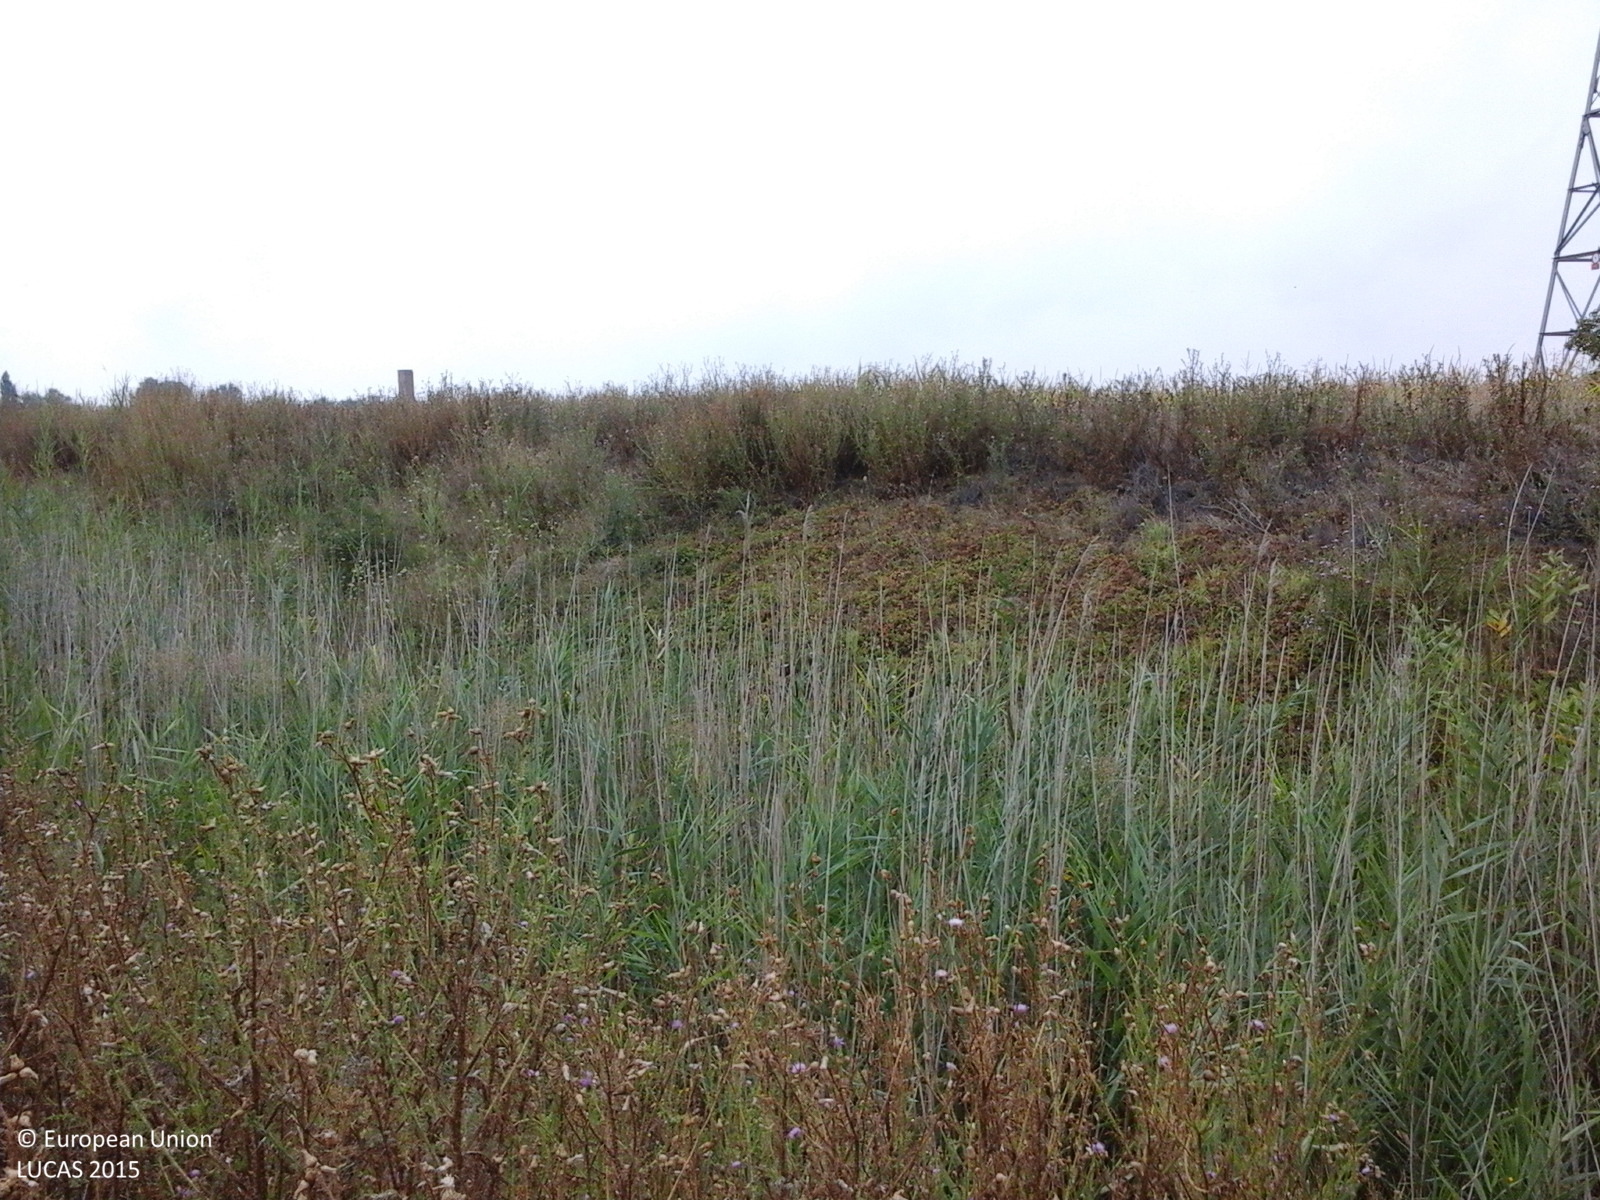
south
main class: Cropland
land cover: Maize
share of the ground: > 75 %
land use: Agriculture (excluding fallow land and kitchen gardens)
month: August
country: RO
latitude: 45.8135
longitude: 20.6937
